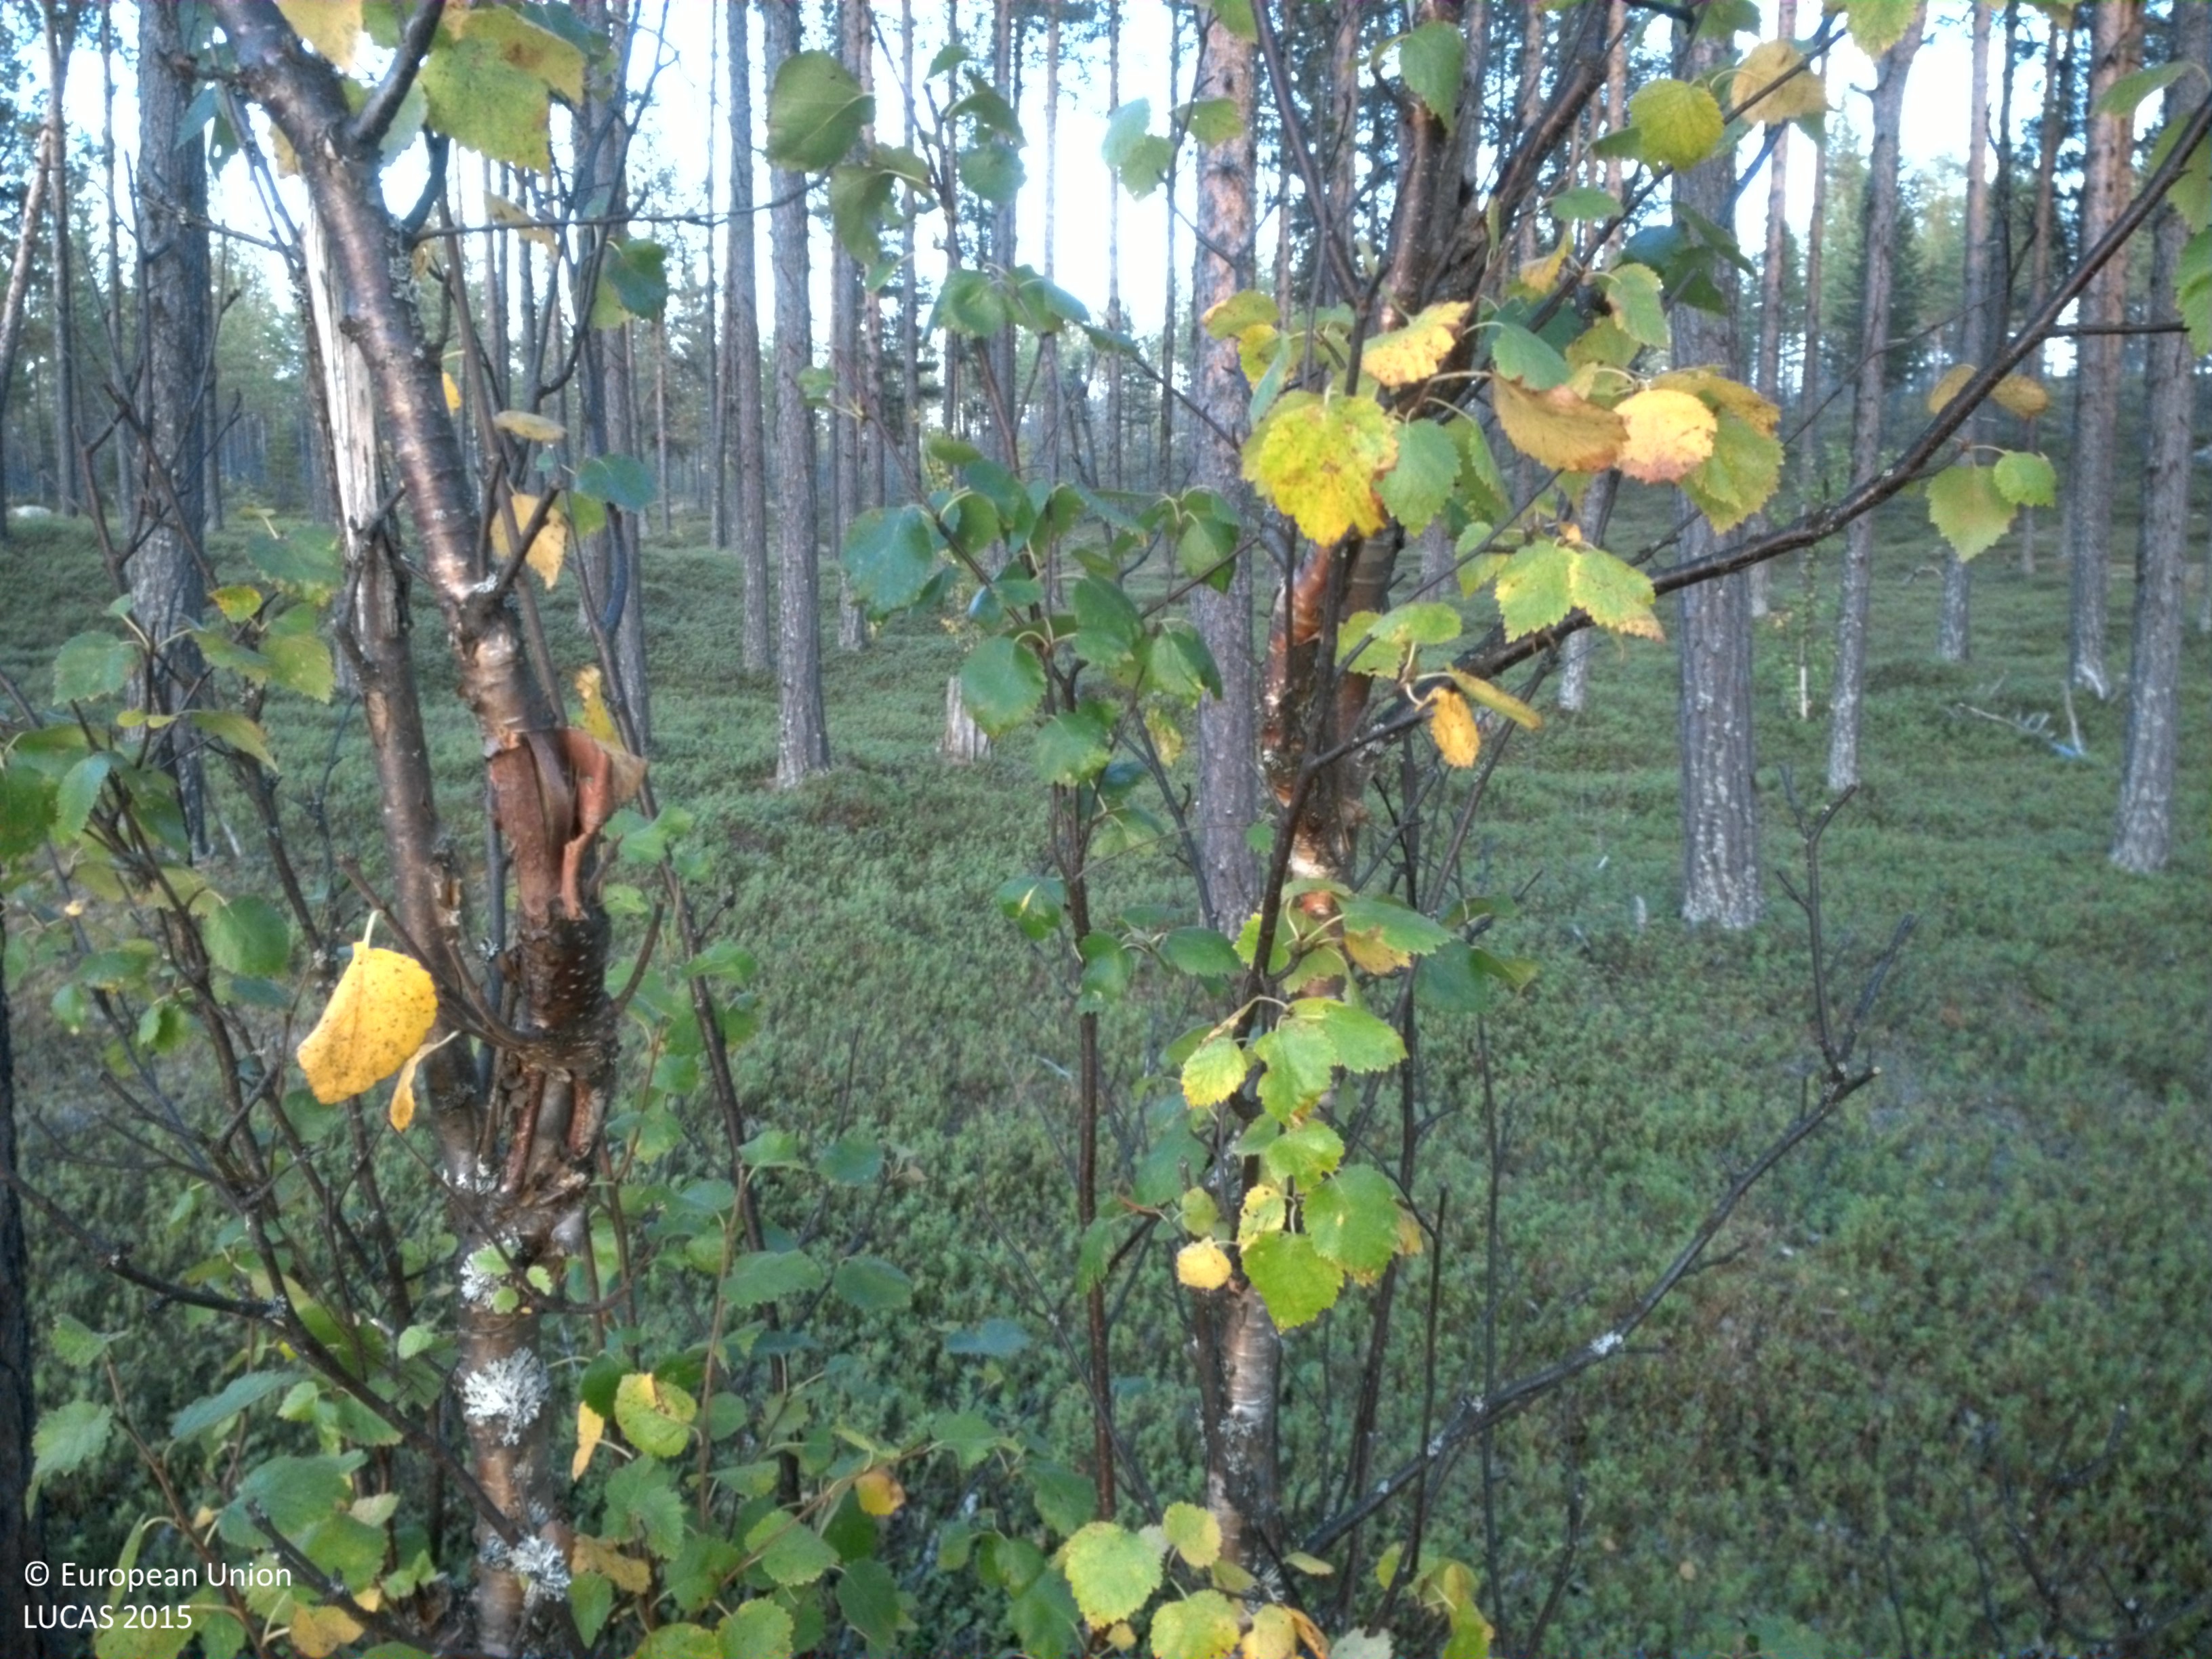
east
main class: Woodland
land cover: Pine dominated mixed woodland
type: boreal forest
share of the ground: 25 - 50 %
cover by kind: shrubs 45 %, broadleaved forest trees 30 %, lichens and mosses 15 %, coniferous forest trees 10 %
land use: Forestry
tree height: > 5 m
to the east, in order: Pine dominated mixed woodland; Pine dominated coniferous woodland; Other bare soil; Abandoned hedges; Paved roads, cycling and walking lanes; Broadleaved woodland; Other mixed woodland; Shrubland with sparse tree cover; Pine dominated mixed woodland
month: September
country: SE
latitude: 65.3293
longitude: 16.6398
